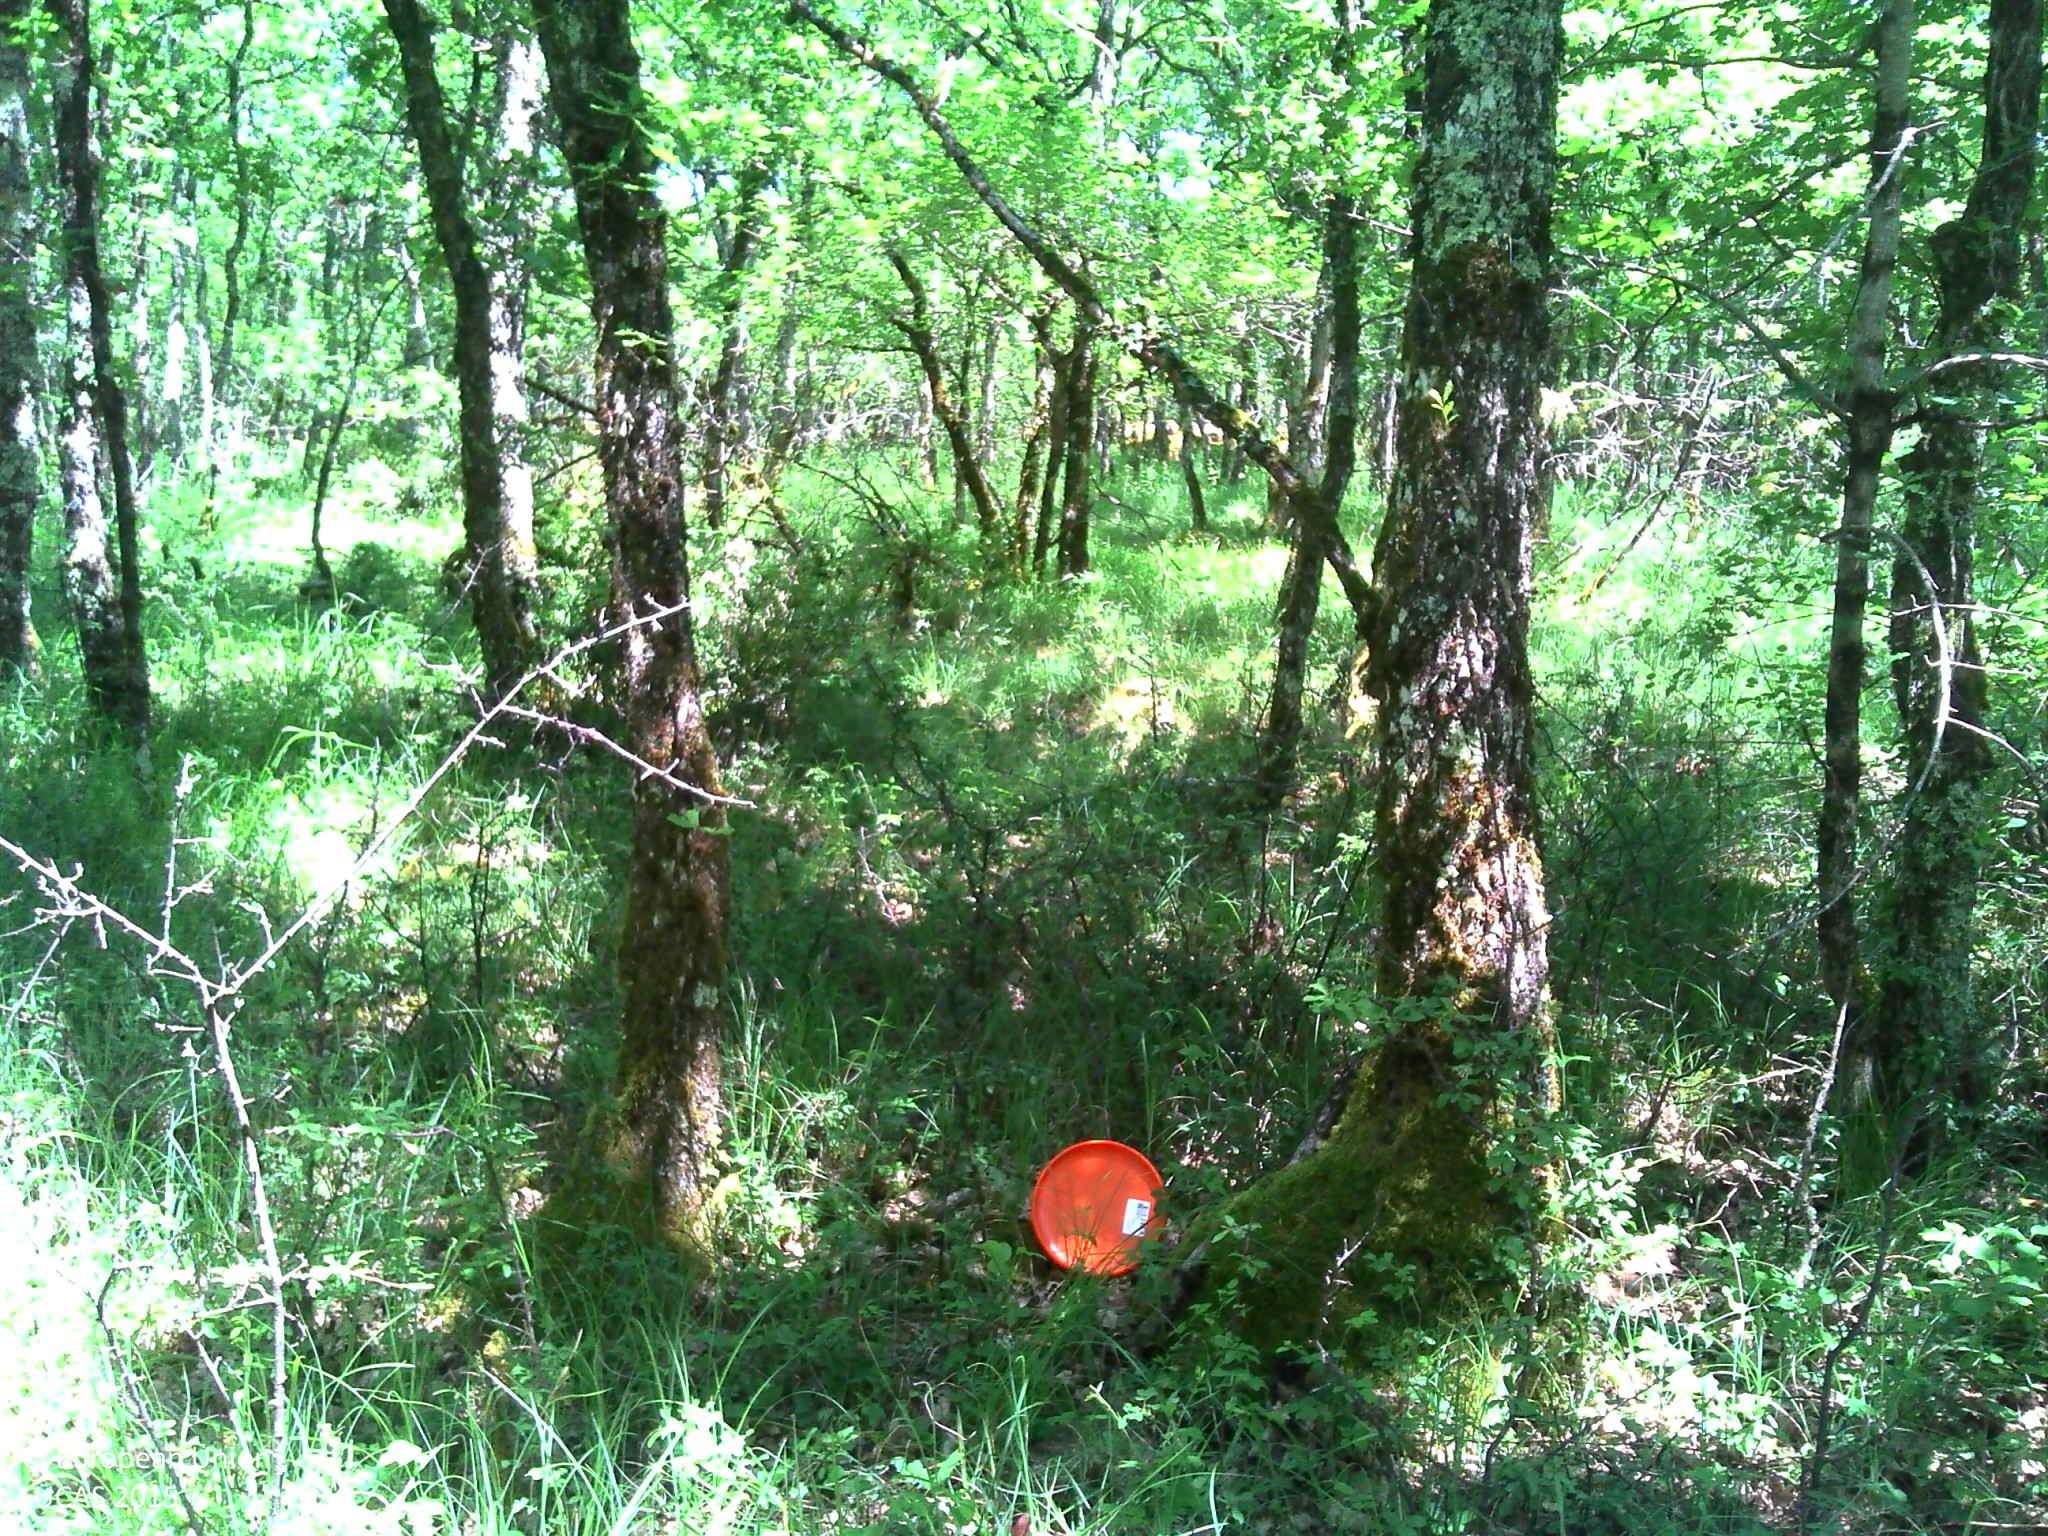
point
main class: Woodland
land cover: Broadleaved woodland
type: thermophilous deciduous forest
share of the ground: > 75 %
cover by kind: broadleaved forest trees 95 %, herbaceous plants 5 %
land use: Forestry
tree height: > 5 m
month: May
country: FR
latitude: 44.5433
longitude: 1.9322
